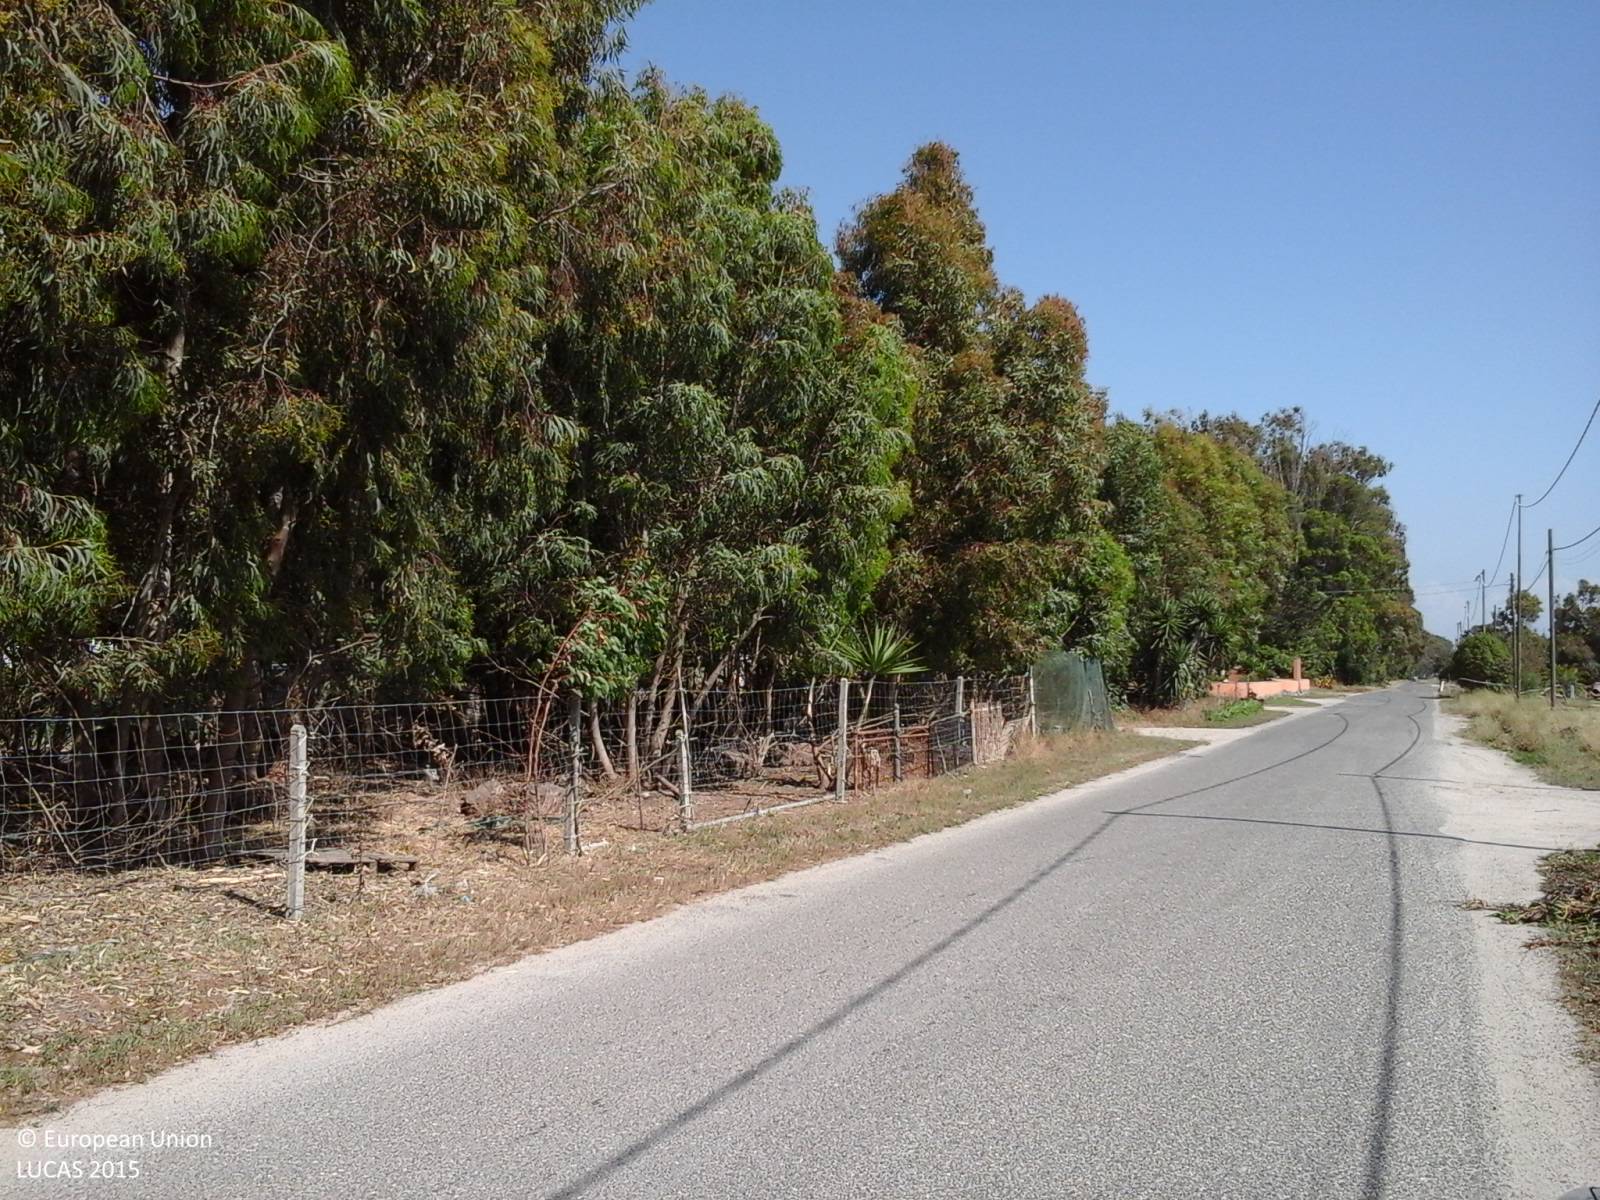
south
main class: Woodland
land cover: Broadleaved woodland
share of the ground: > 75 %
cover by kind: broadleaved forest trees 80 %, herbaceous plants 20 %
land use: Forestry
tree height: > 5 m
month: May
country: IT
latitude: 39.8408
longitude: 8.5938
